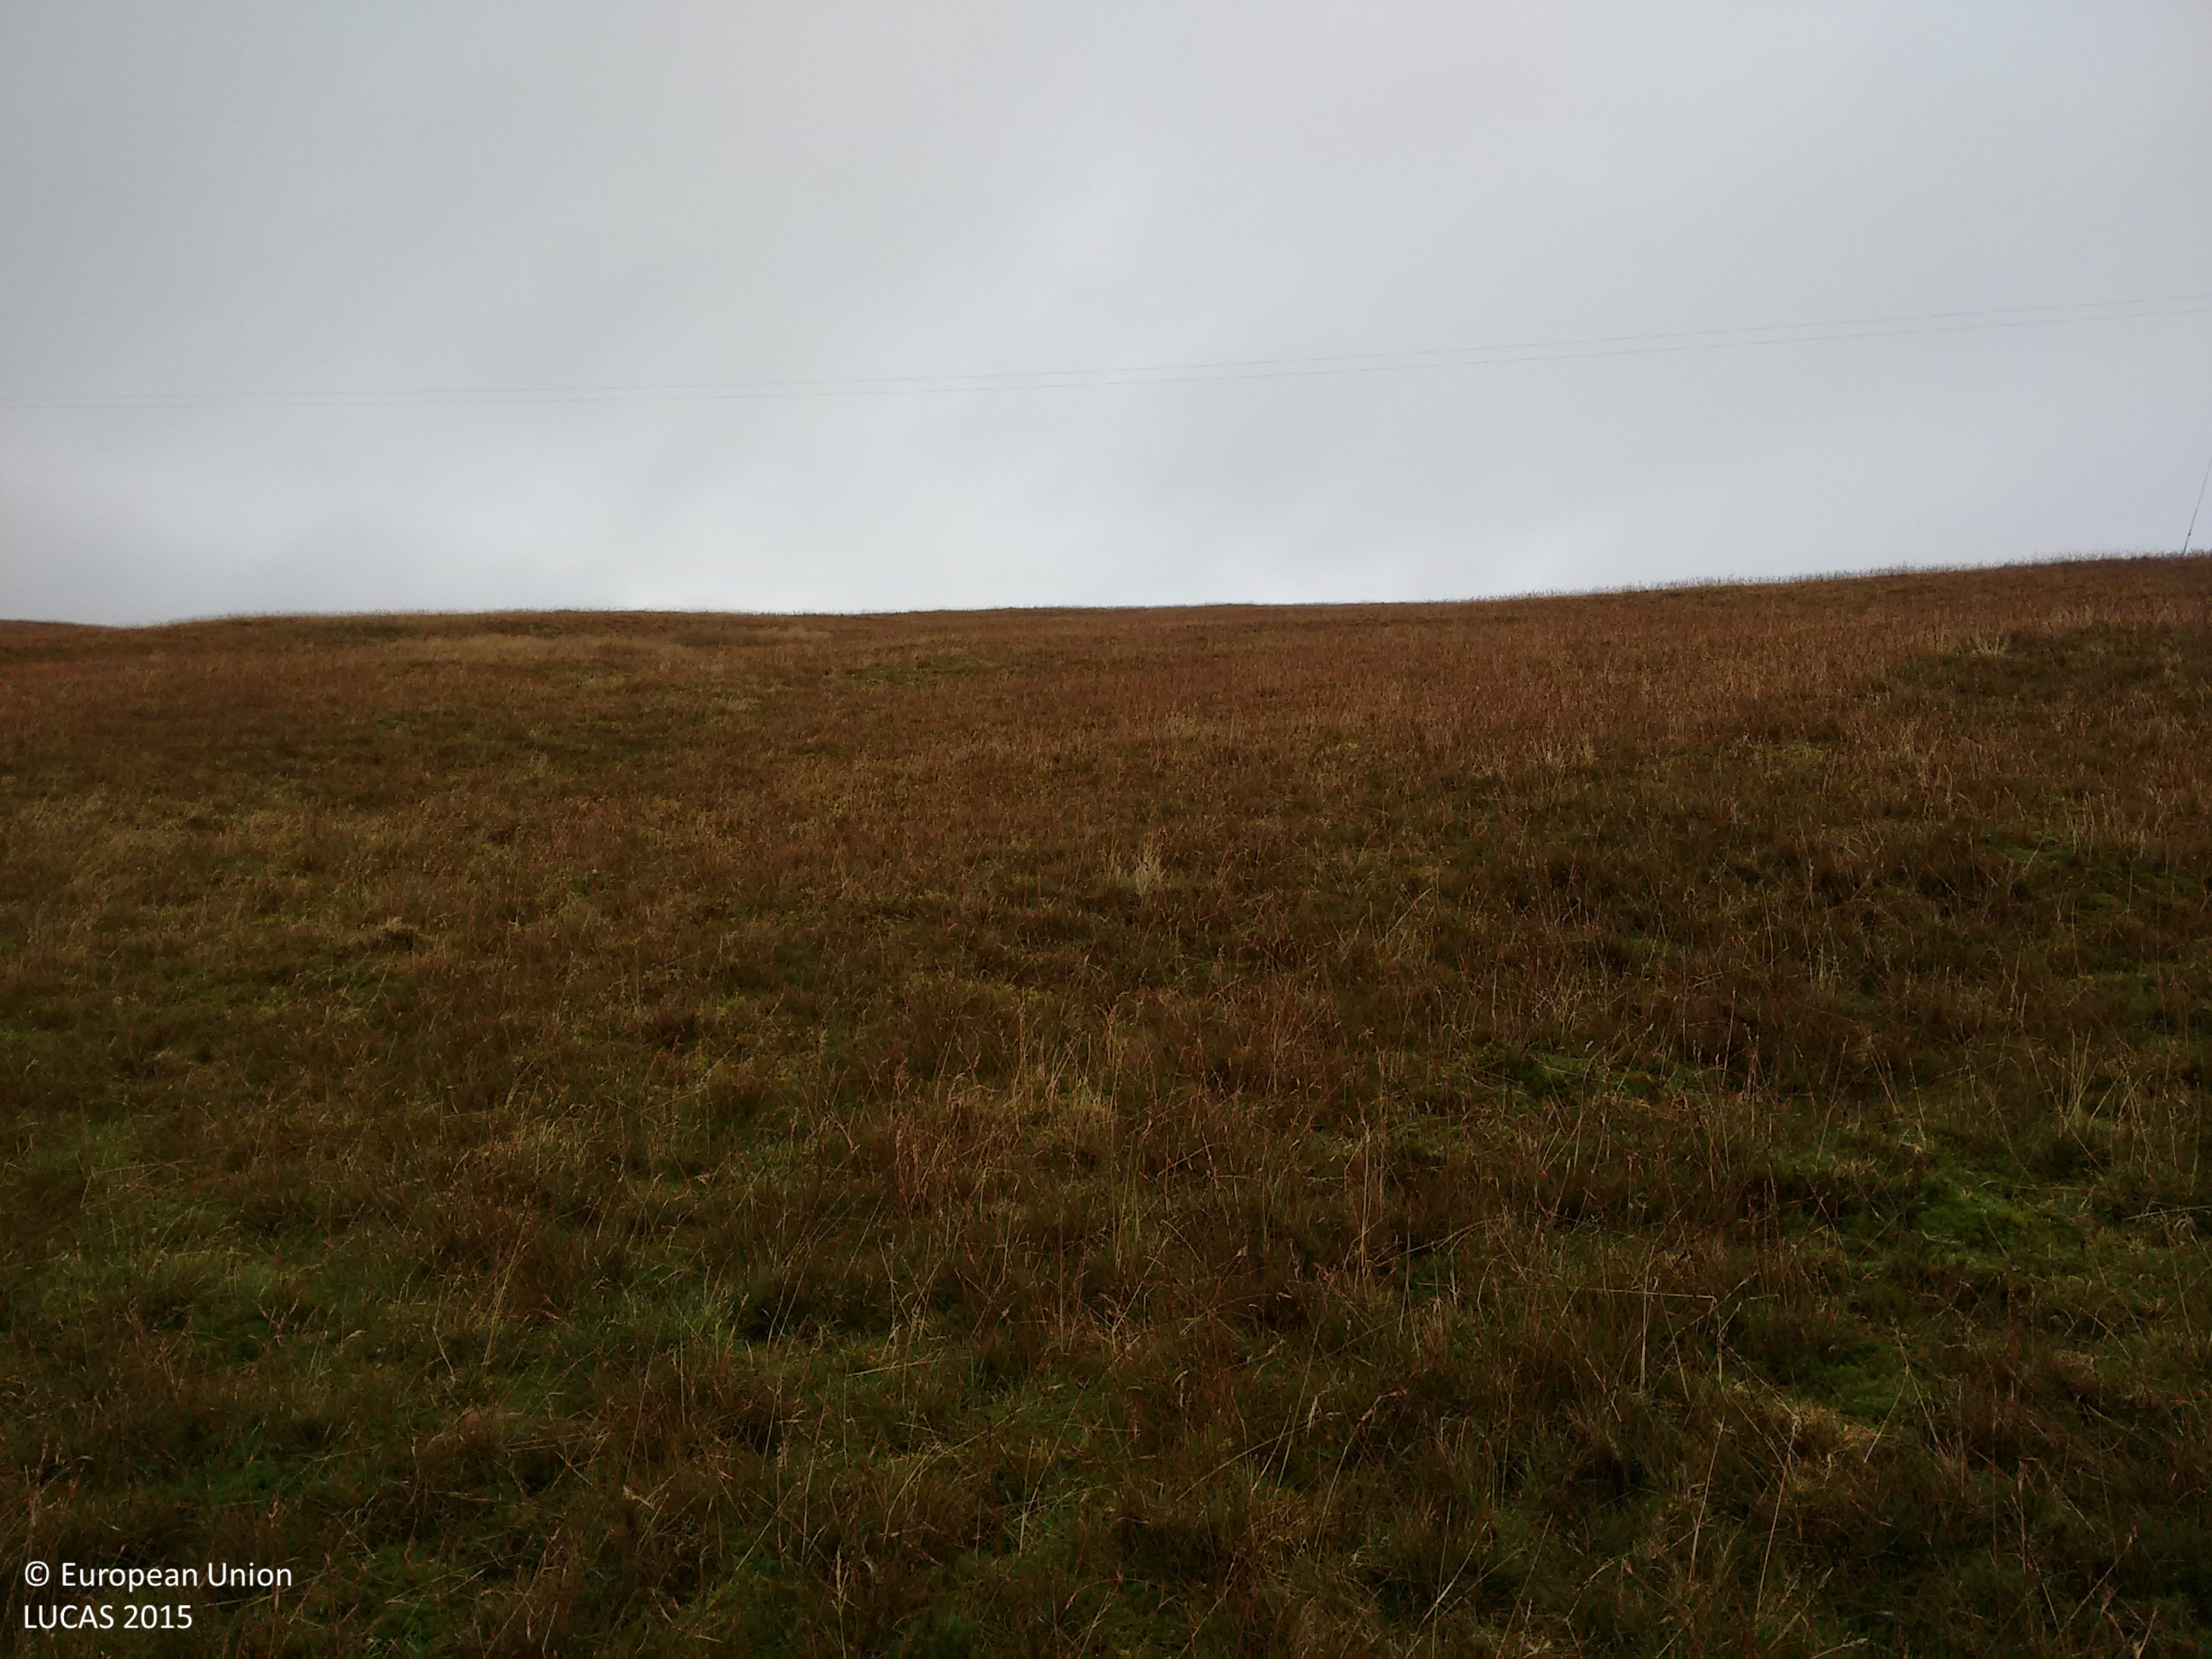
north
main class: Grassland
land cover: Grassland without tree/shrub cover
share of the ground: > 75 %
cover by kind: herbaceous plants 70 %, lichens and mosses 30 %
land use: Agriculture (excluding fallow land and kitchen gardens)
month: November
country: GB
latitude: 60.5239
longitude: -1.3321
